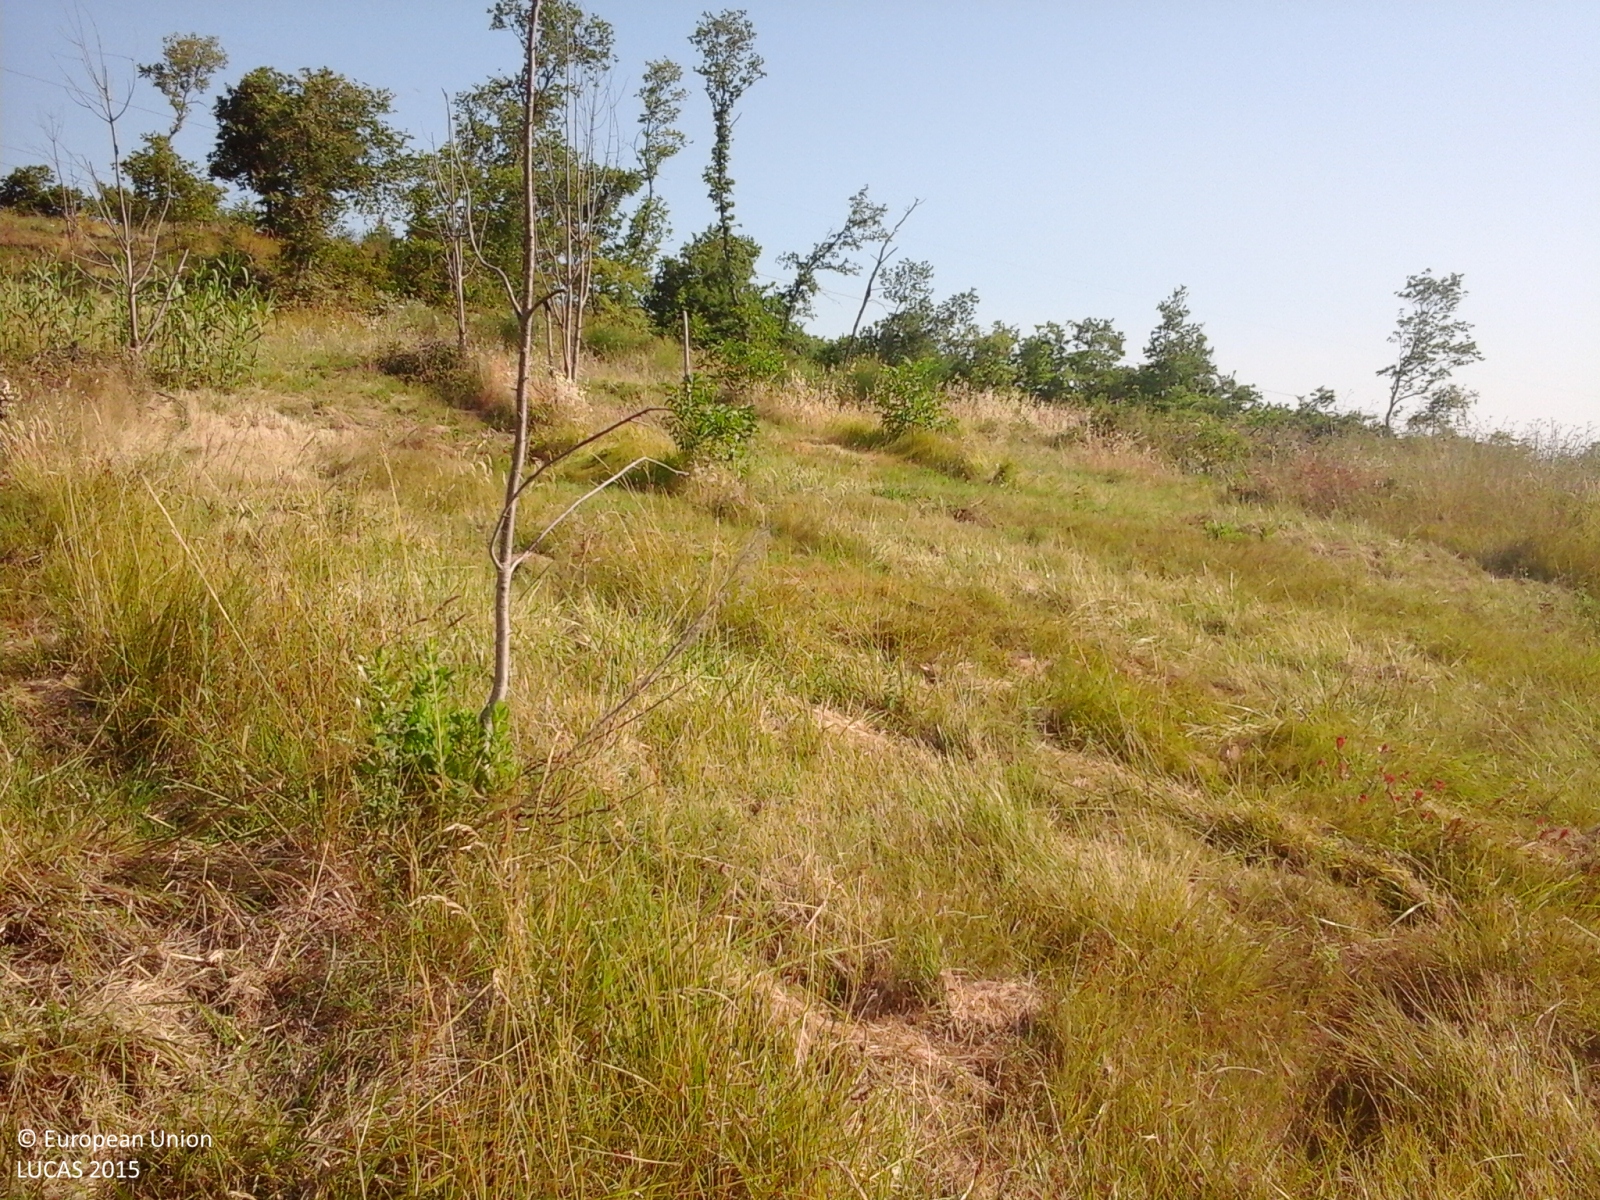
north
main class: Cropland
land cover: Nuts trees
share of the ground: 25 - 50 %
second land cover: Grassland without tree/shrub cover
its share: > 75 %
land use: Agriculture (excluding fallow land and kitchen gardens)
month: July
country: IT
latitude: 41.0977
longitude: 14.6849
